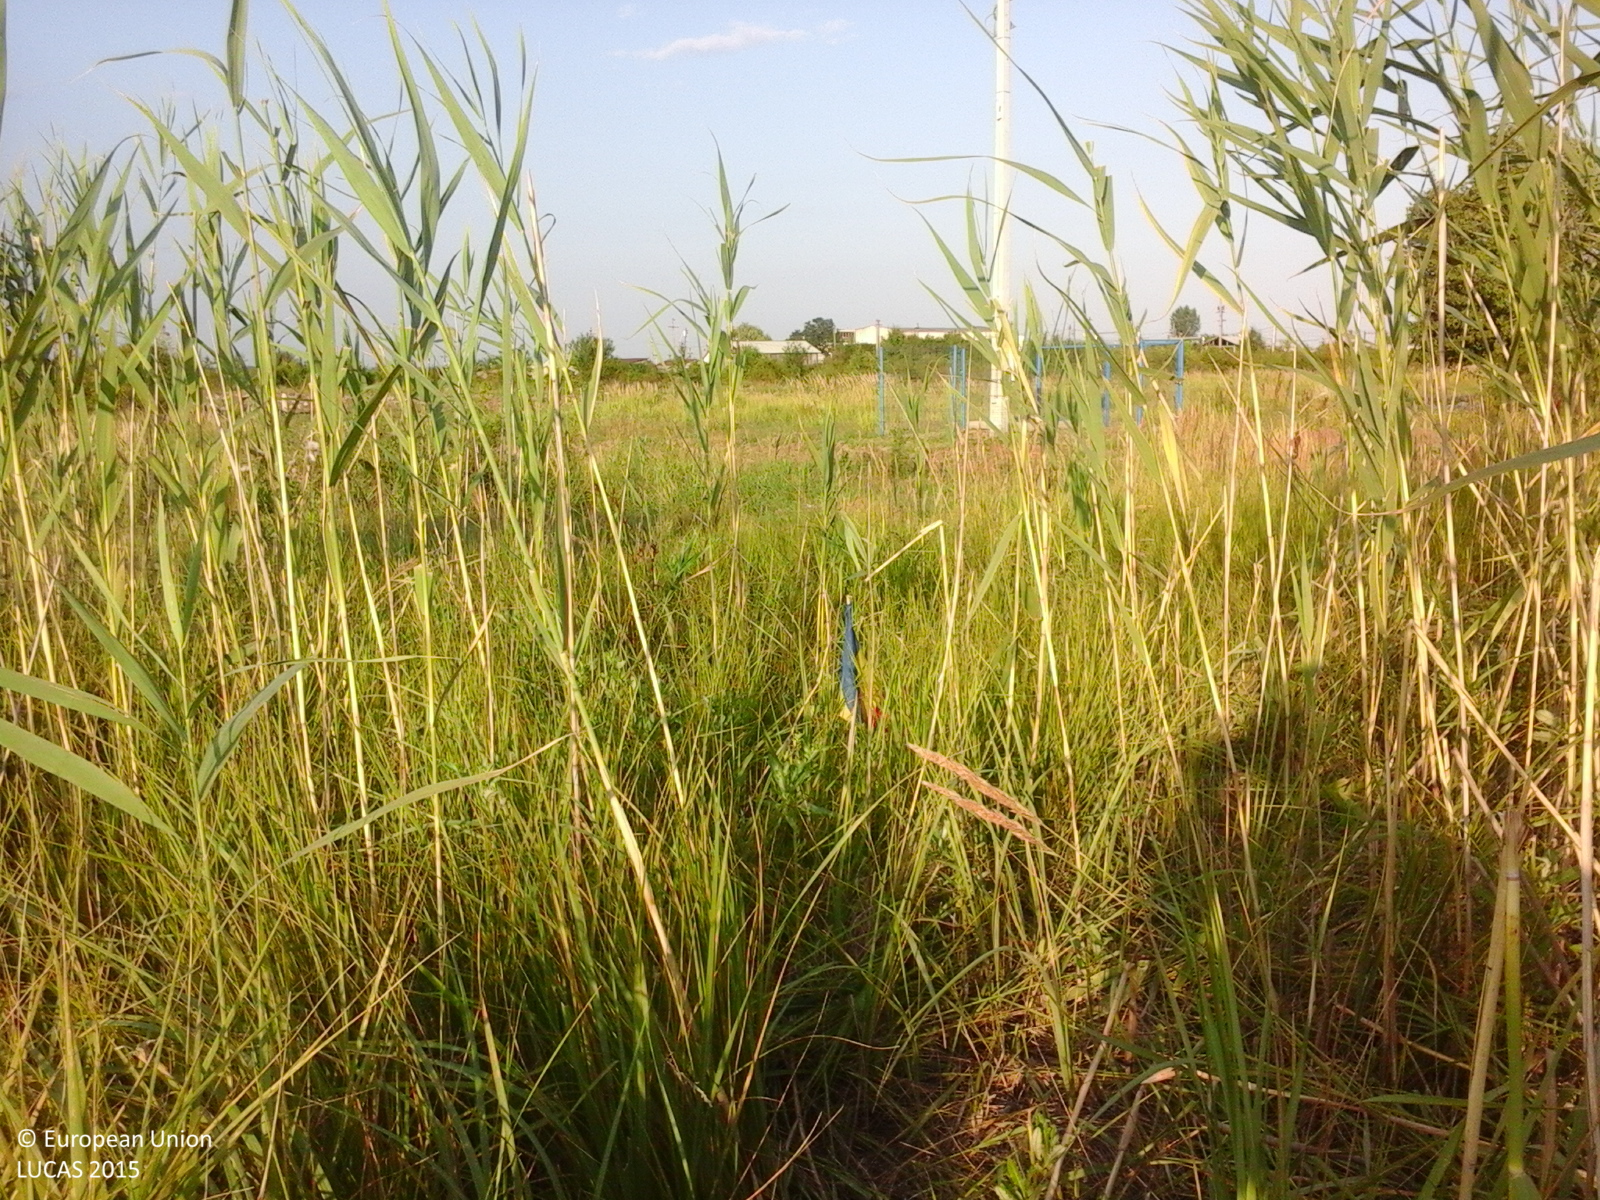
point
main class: Grassland
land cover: Spontaneously vegetated surfaces
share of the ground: > 75 %
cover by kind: herbaceous plants 100 %
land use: Semi-natural and natural areas not in use
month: July
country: RO
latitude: 44.4130
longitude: 24.7047
